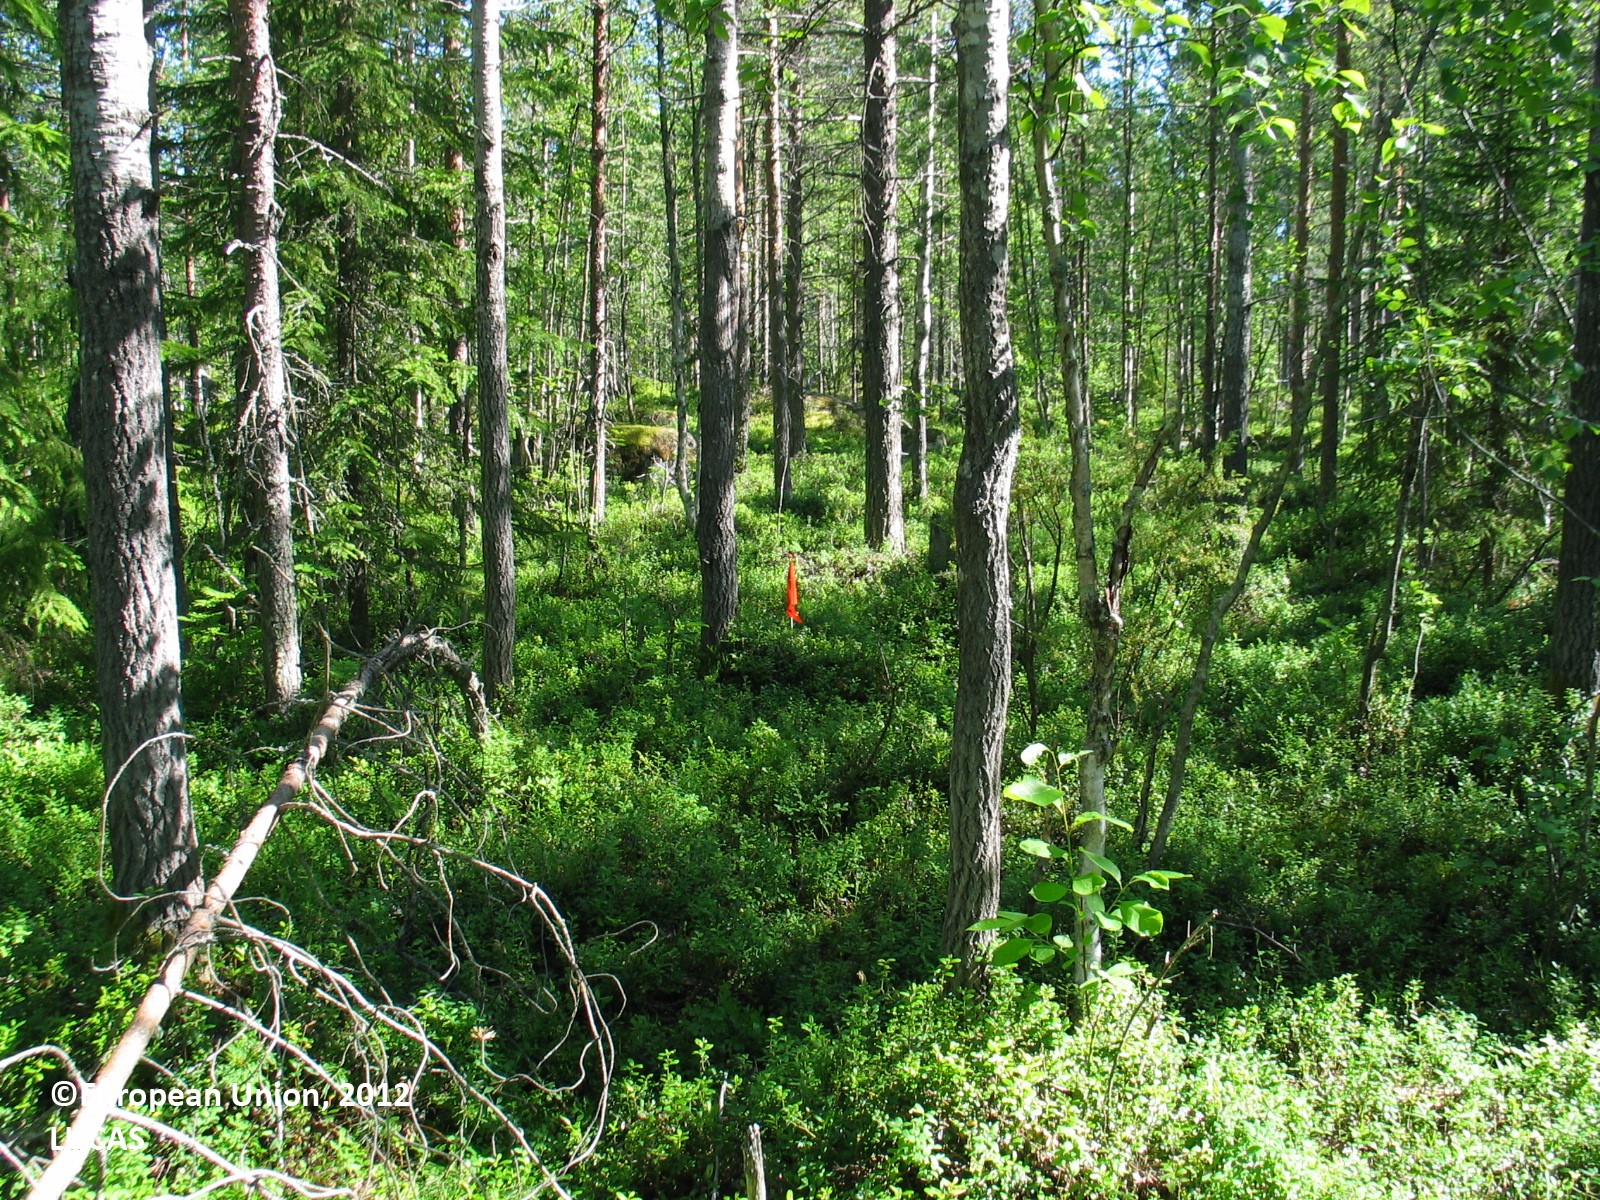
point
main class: Woodland
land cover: Pine dominated mixed woodland
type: boreal forest
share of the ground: 50 - 75 %
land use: Forestry
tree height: > 5 m
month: July
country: FI
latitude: 65.7828
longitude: 25.0297
